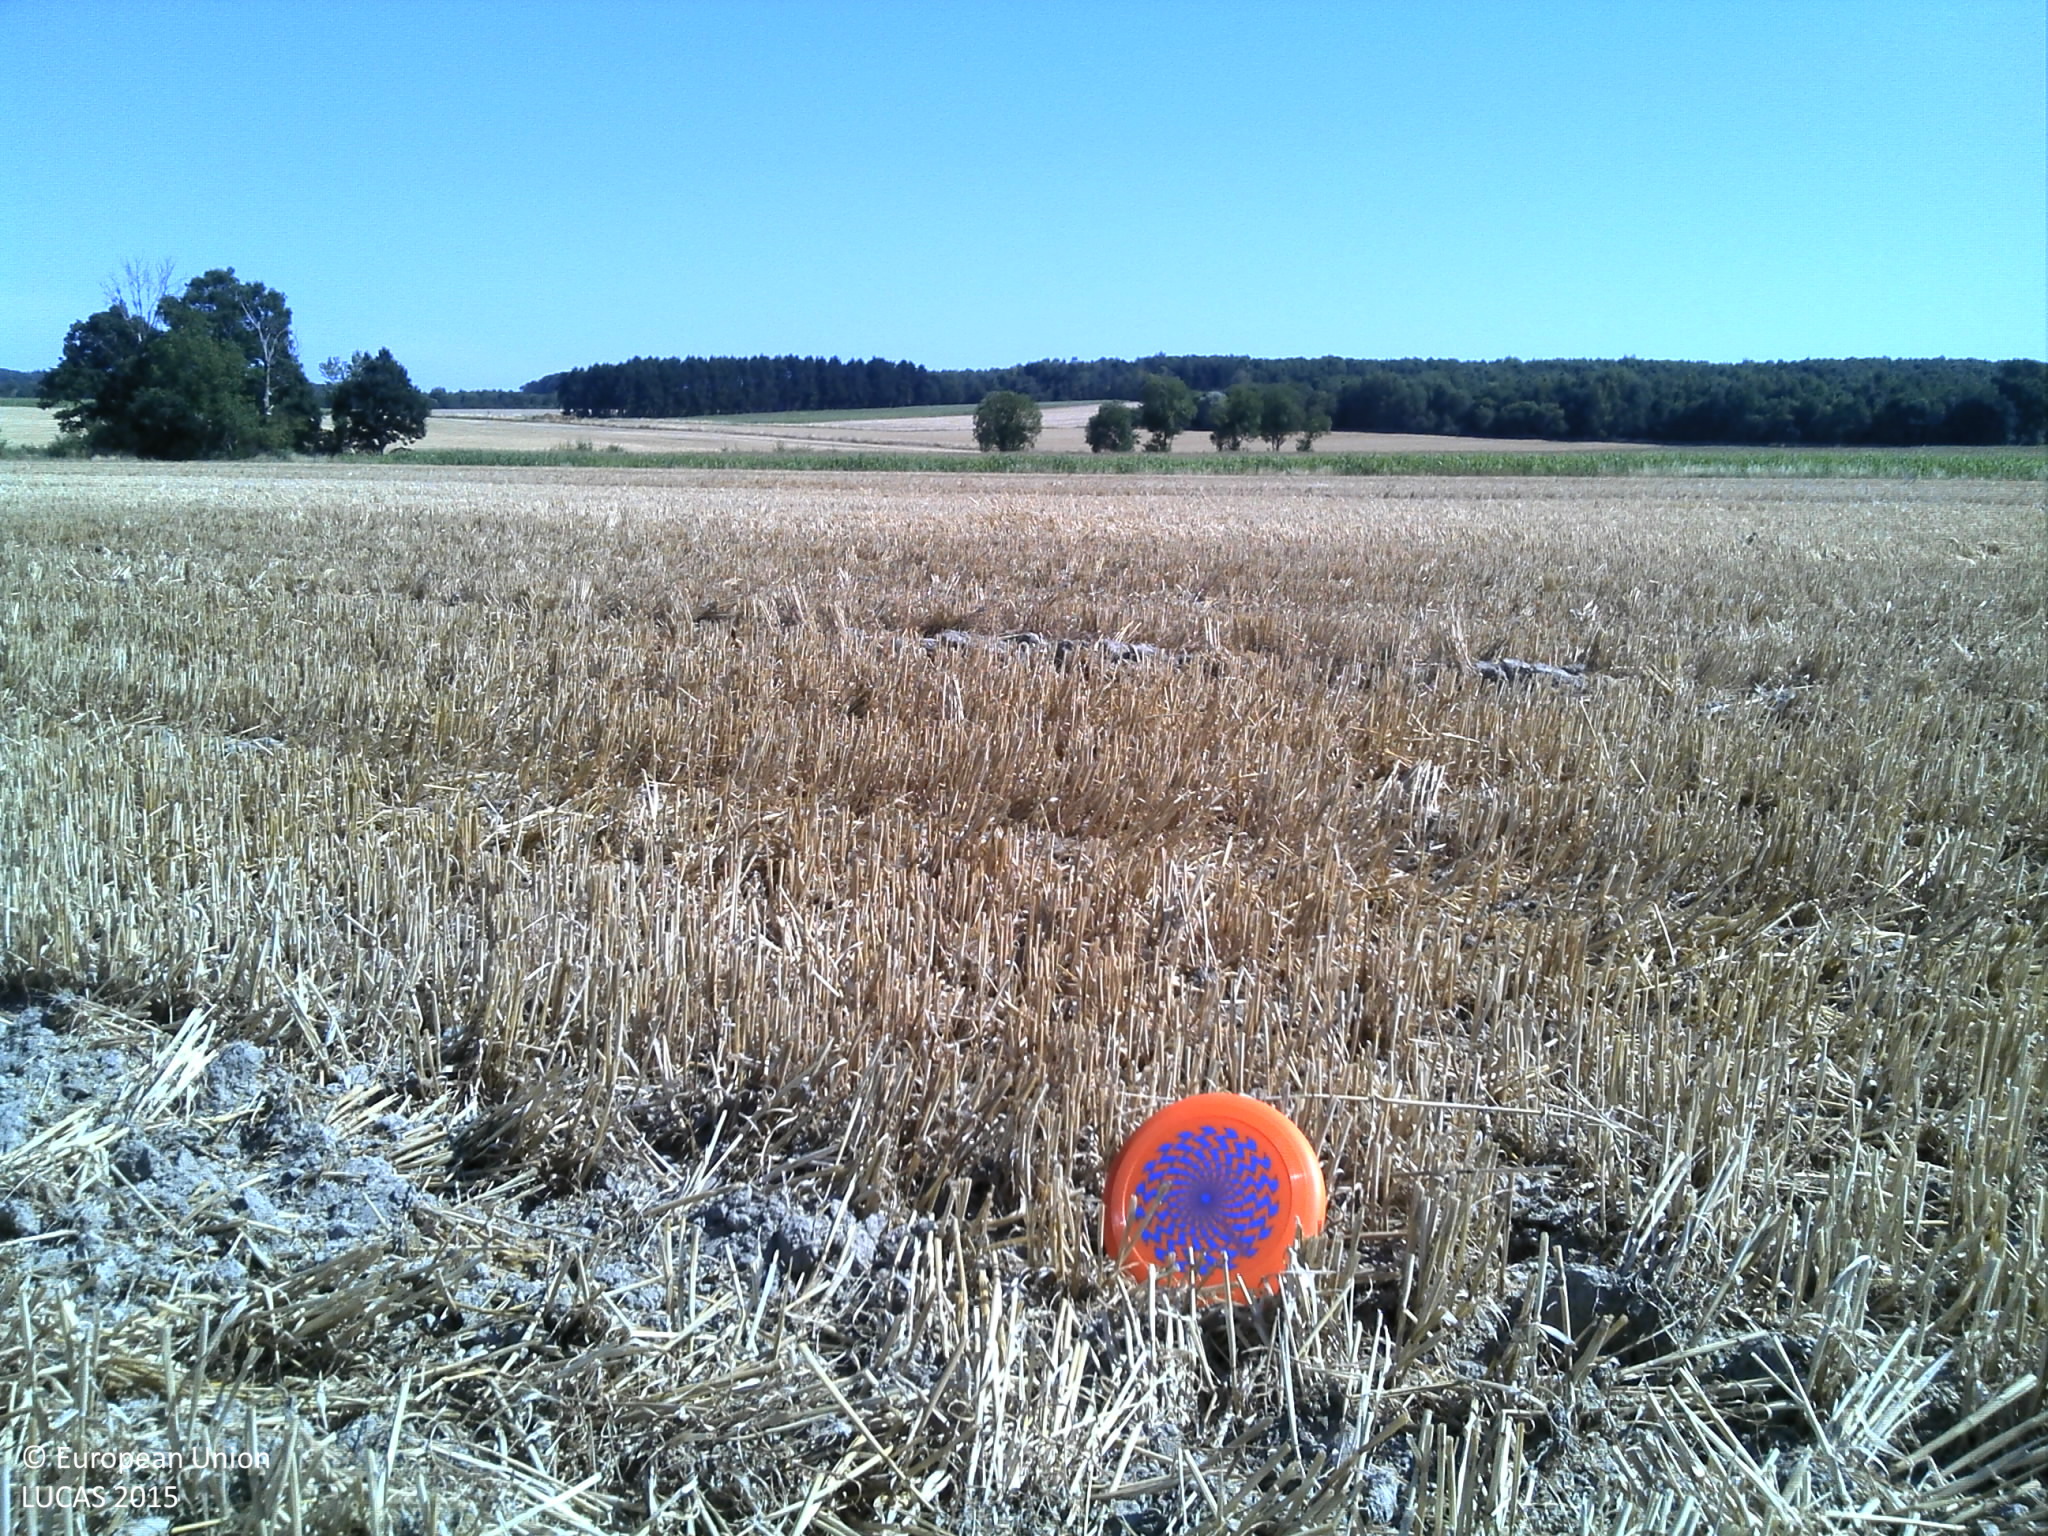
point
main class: Cropland
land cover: Common wheat
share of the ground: > 75 %
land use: Agriculture (excluding fallow land and kitchen gardens)
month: August
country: FR
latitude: 49.2029
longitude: 4.8506
